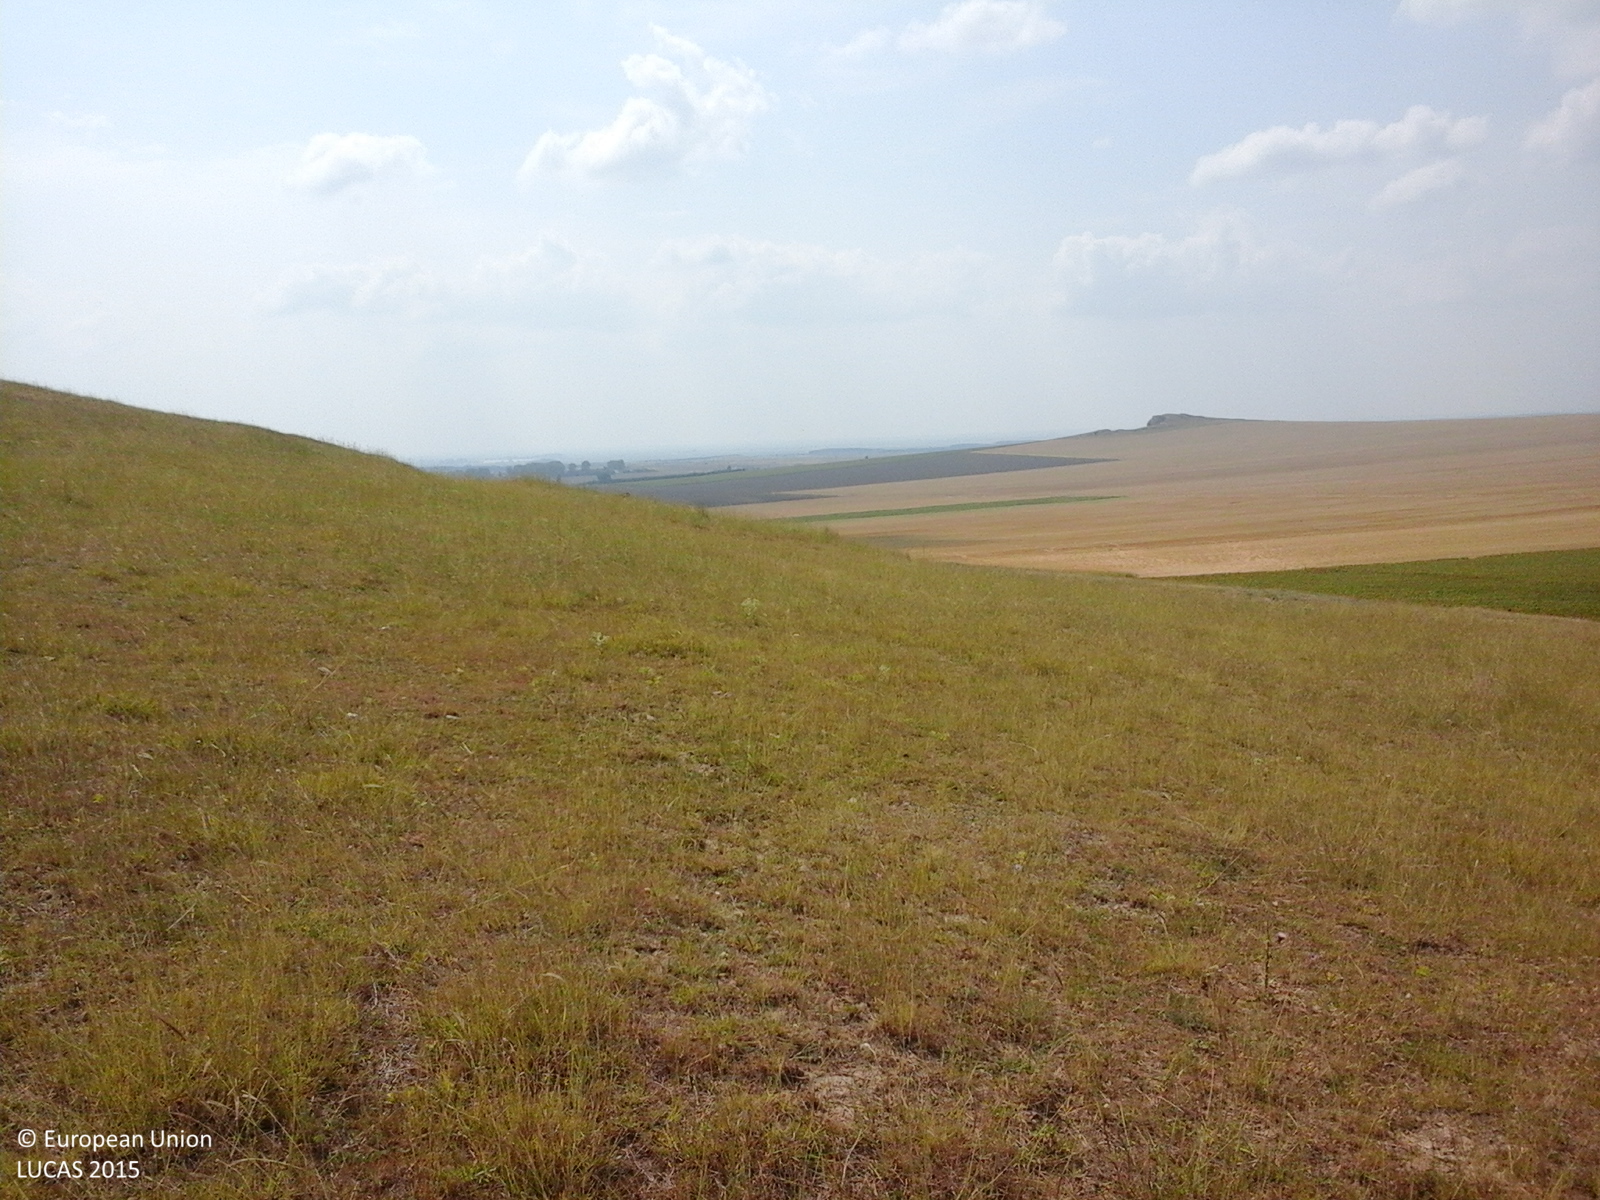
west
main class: Grassland
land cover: Grassland without tree/shrub cover
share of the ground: > 75 %
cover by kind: herbaceous plants 100 %
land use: Agriculture (excluding fallow land and kitchen gardens)
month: July
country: RO
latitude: 45.1516
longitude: 28.2474
